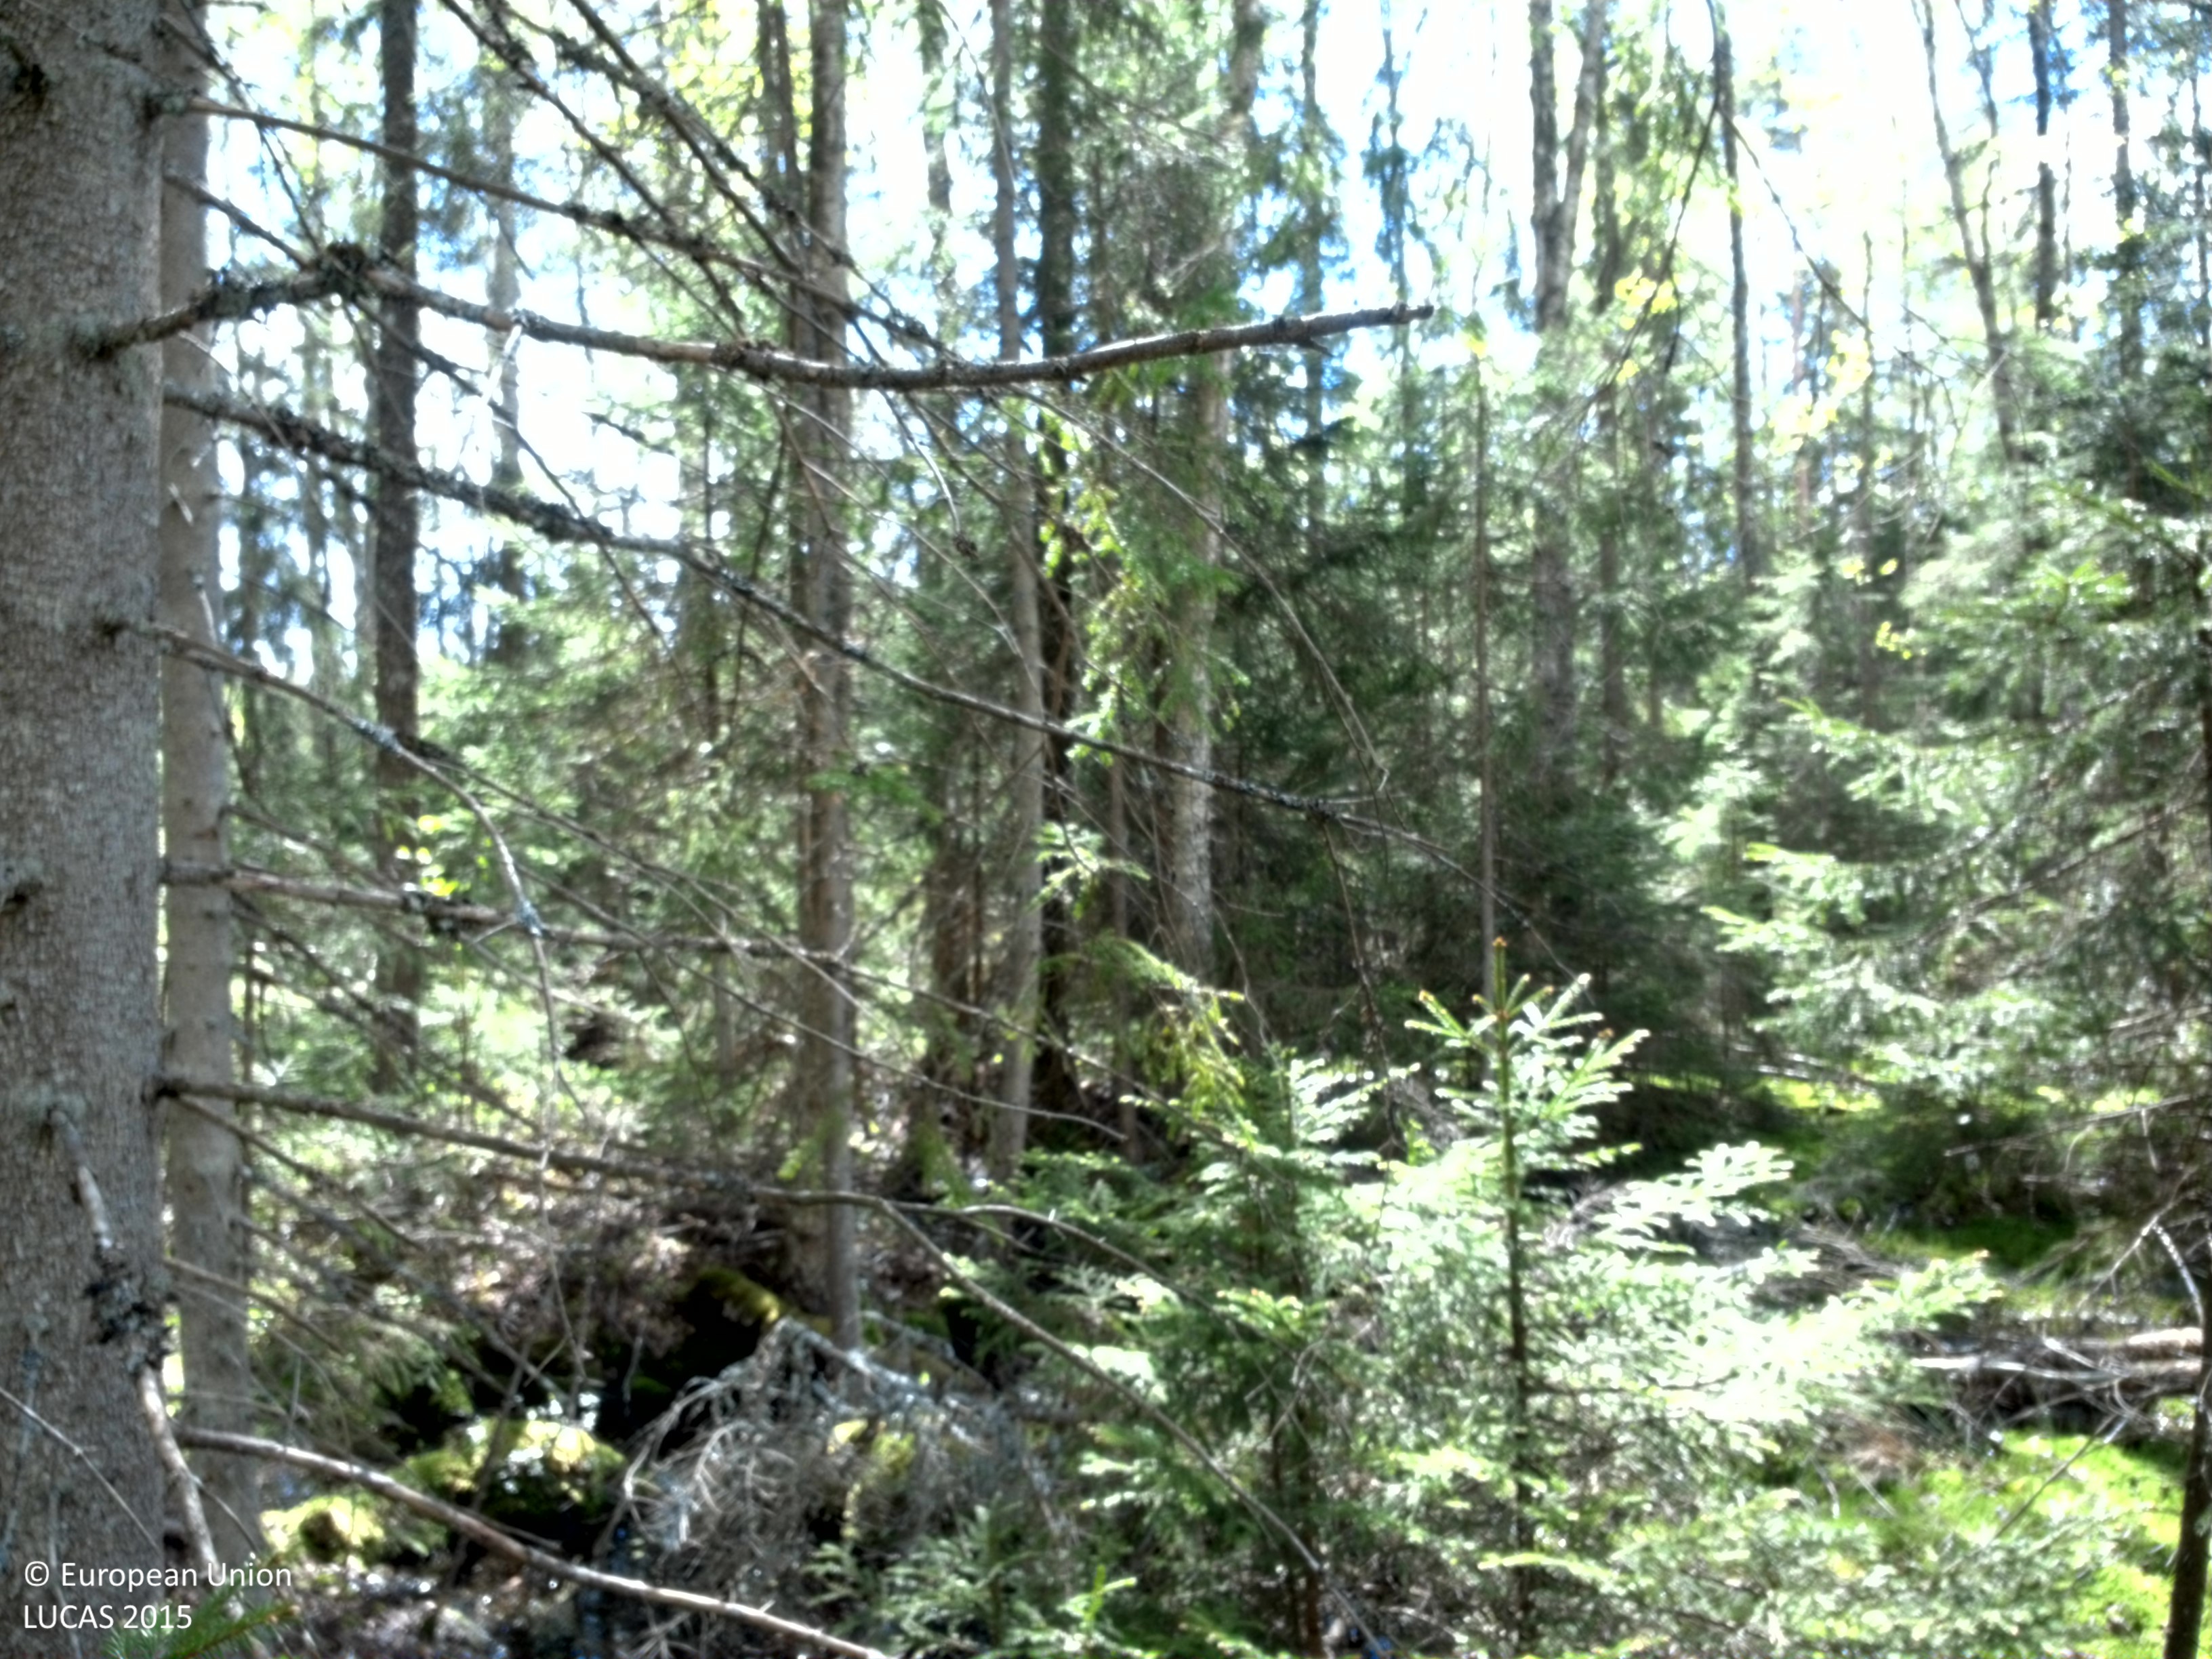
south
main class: Woodland
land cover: Spruce dominated mixed woodland
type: boreal forest
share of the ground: > 75 %
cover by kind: broadleaved forest trees 50 %, coniferous forest trees 40 %, lichens and mosses 10 %
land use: Forestry
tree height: > 5 m
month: May
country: SE
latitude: 56.7319
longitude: 15.1794
